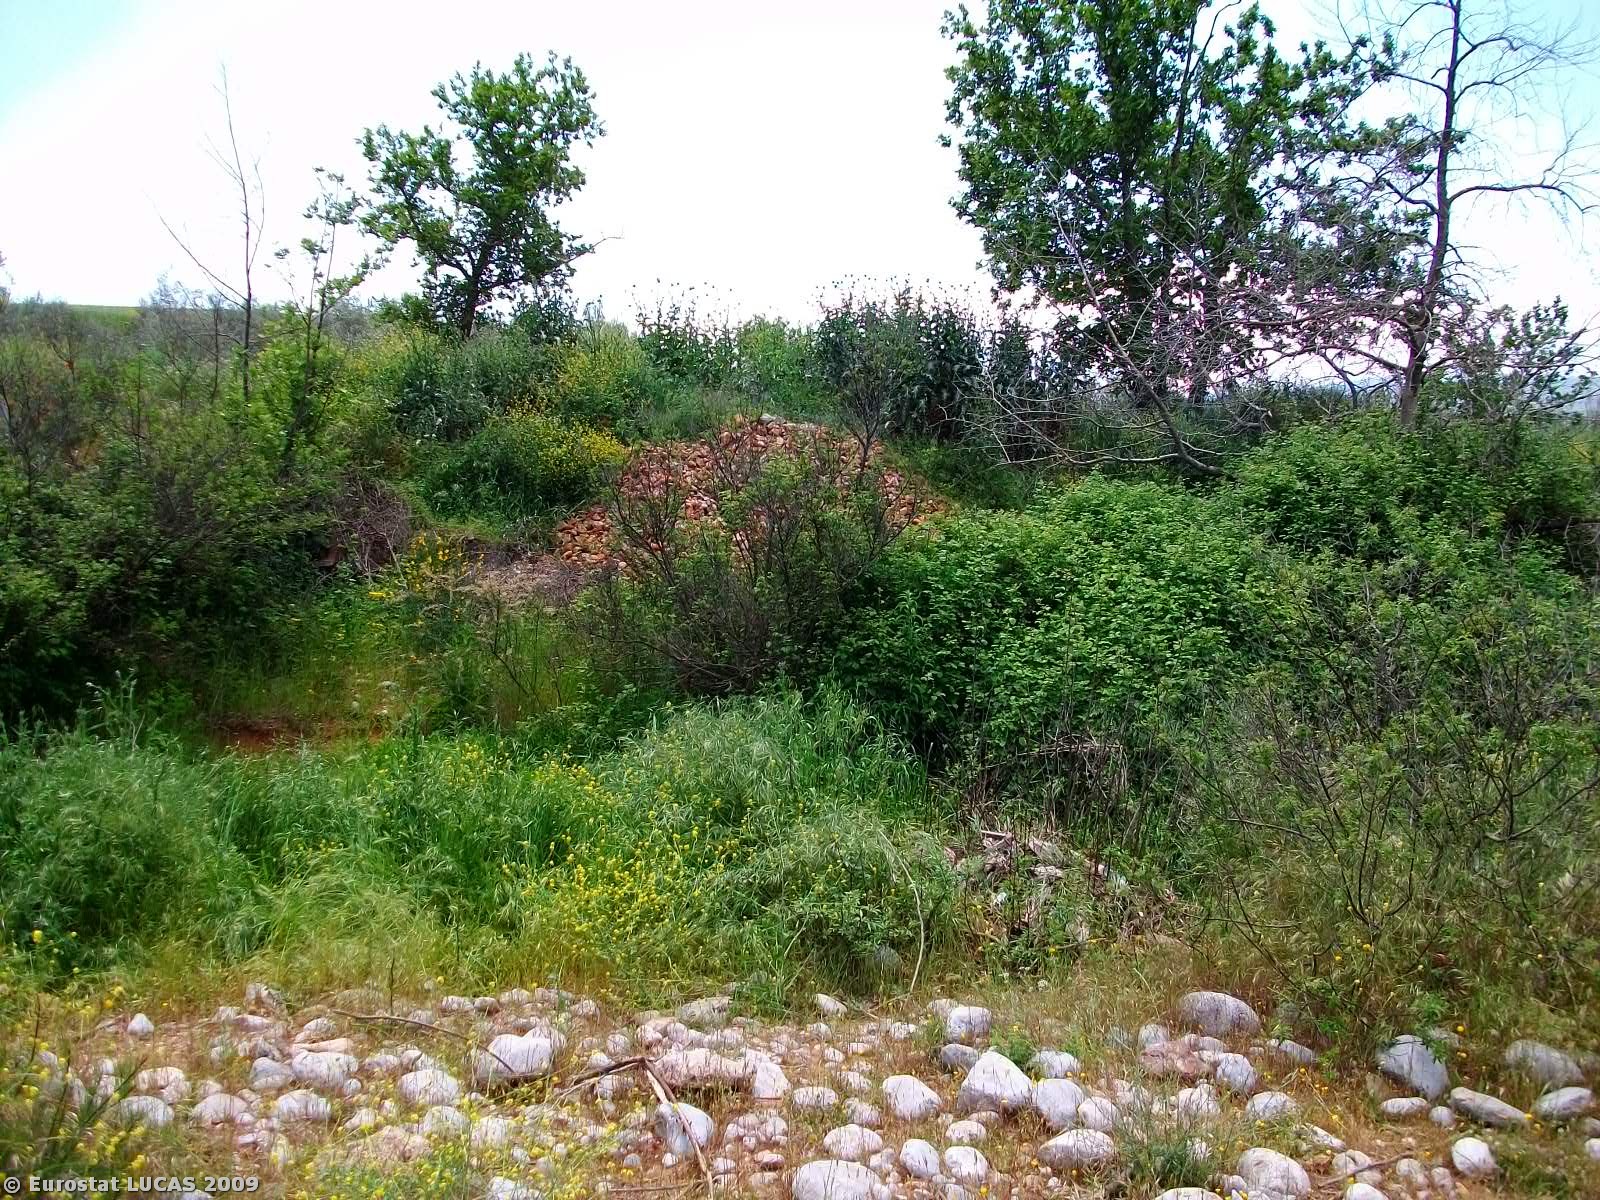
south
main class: Bare land
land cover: Bare land
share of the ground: > 75 %
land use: Unused
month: May
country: GR
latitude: 39.1750
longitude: 22.7546
